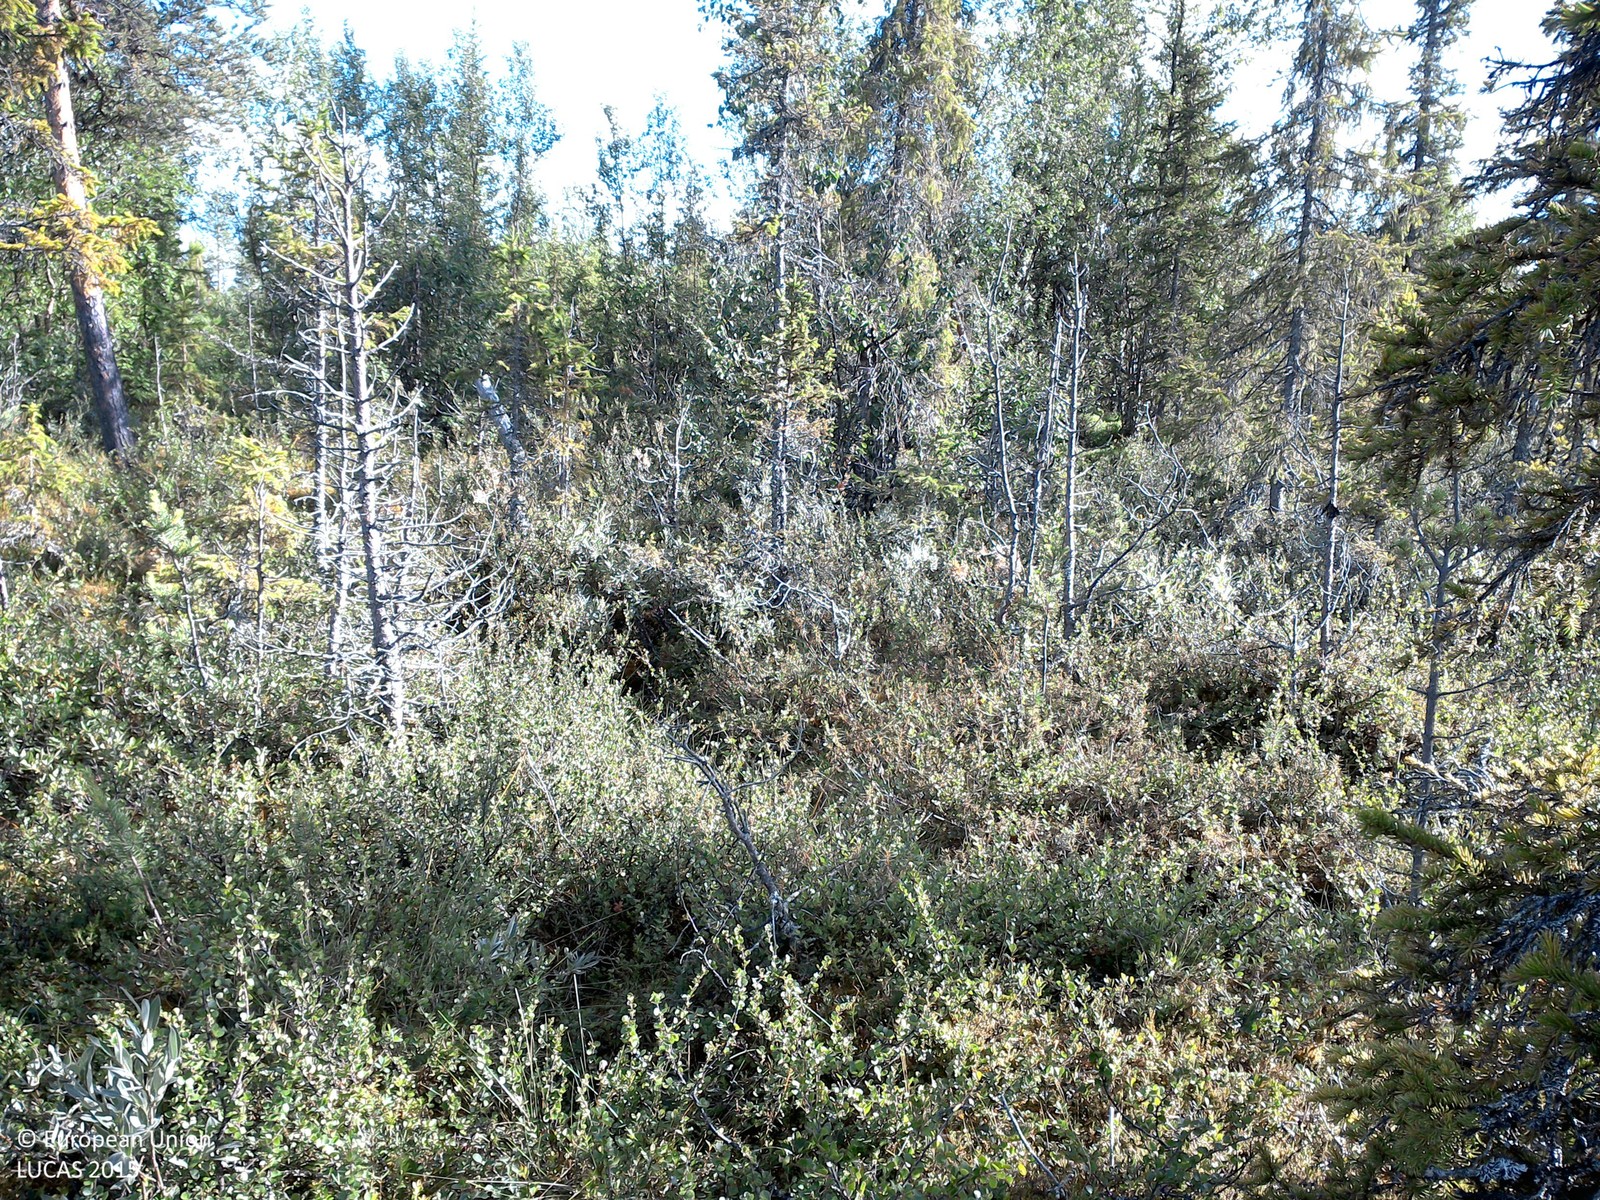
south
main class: Woodland
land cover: Pine dominated coniferous woodland
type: boreal forest
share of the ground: 10 - 25 %
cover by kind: shrubs 75 %, coniferous forest trees 15 %, lichens and mosses 10 %
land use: Semi-natural and natural areas not in use
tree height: > 5 m
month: July
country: SE
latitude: 67.7224
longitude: 21.1251
